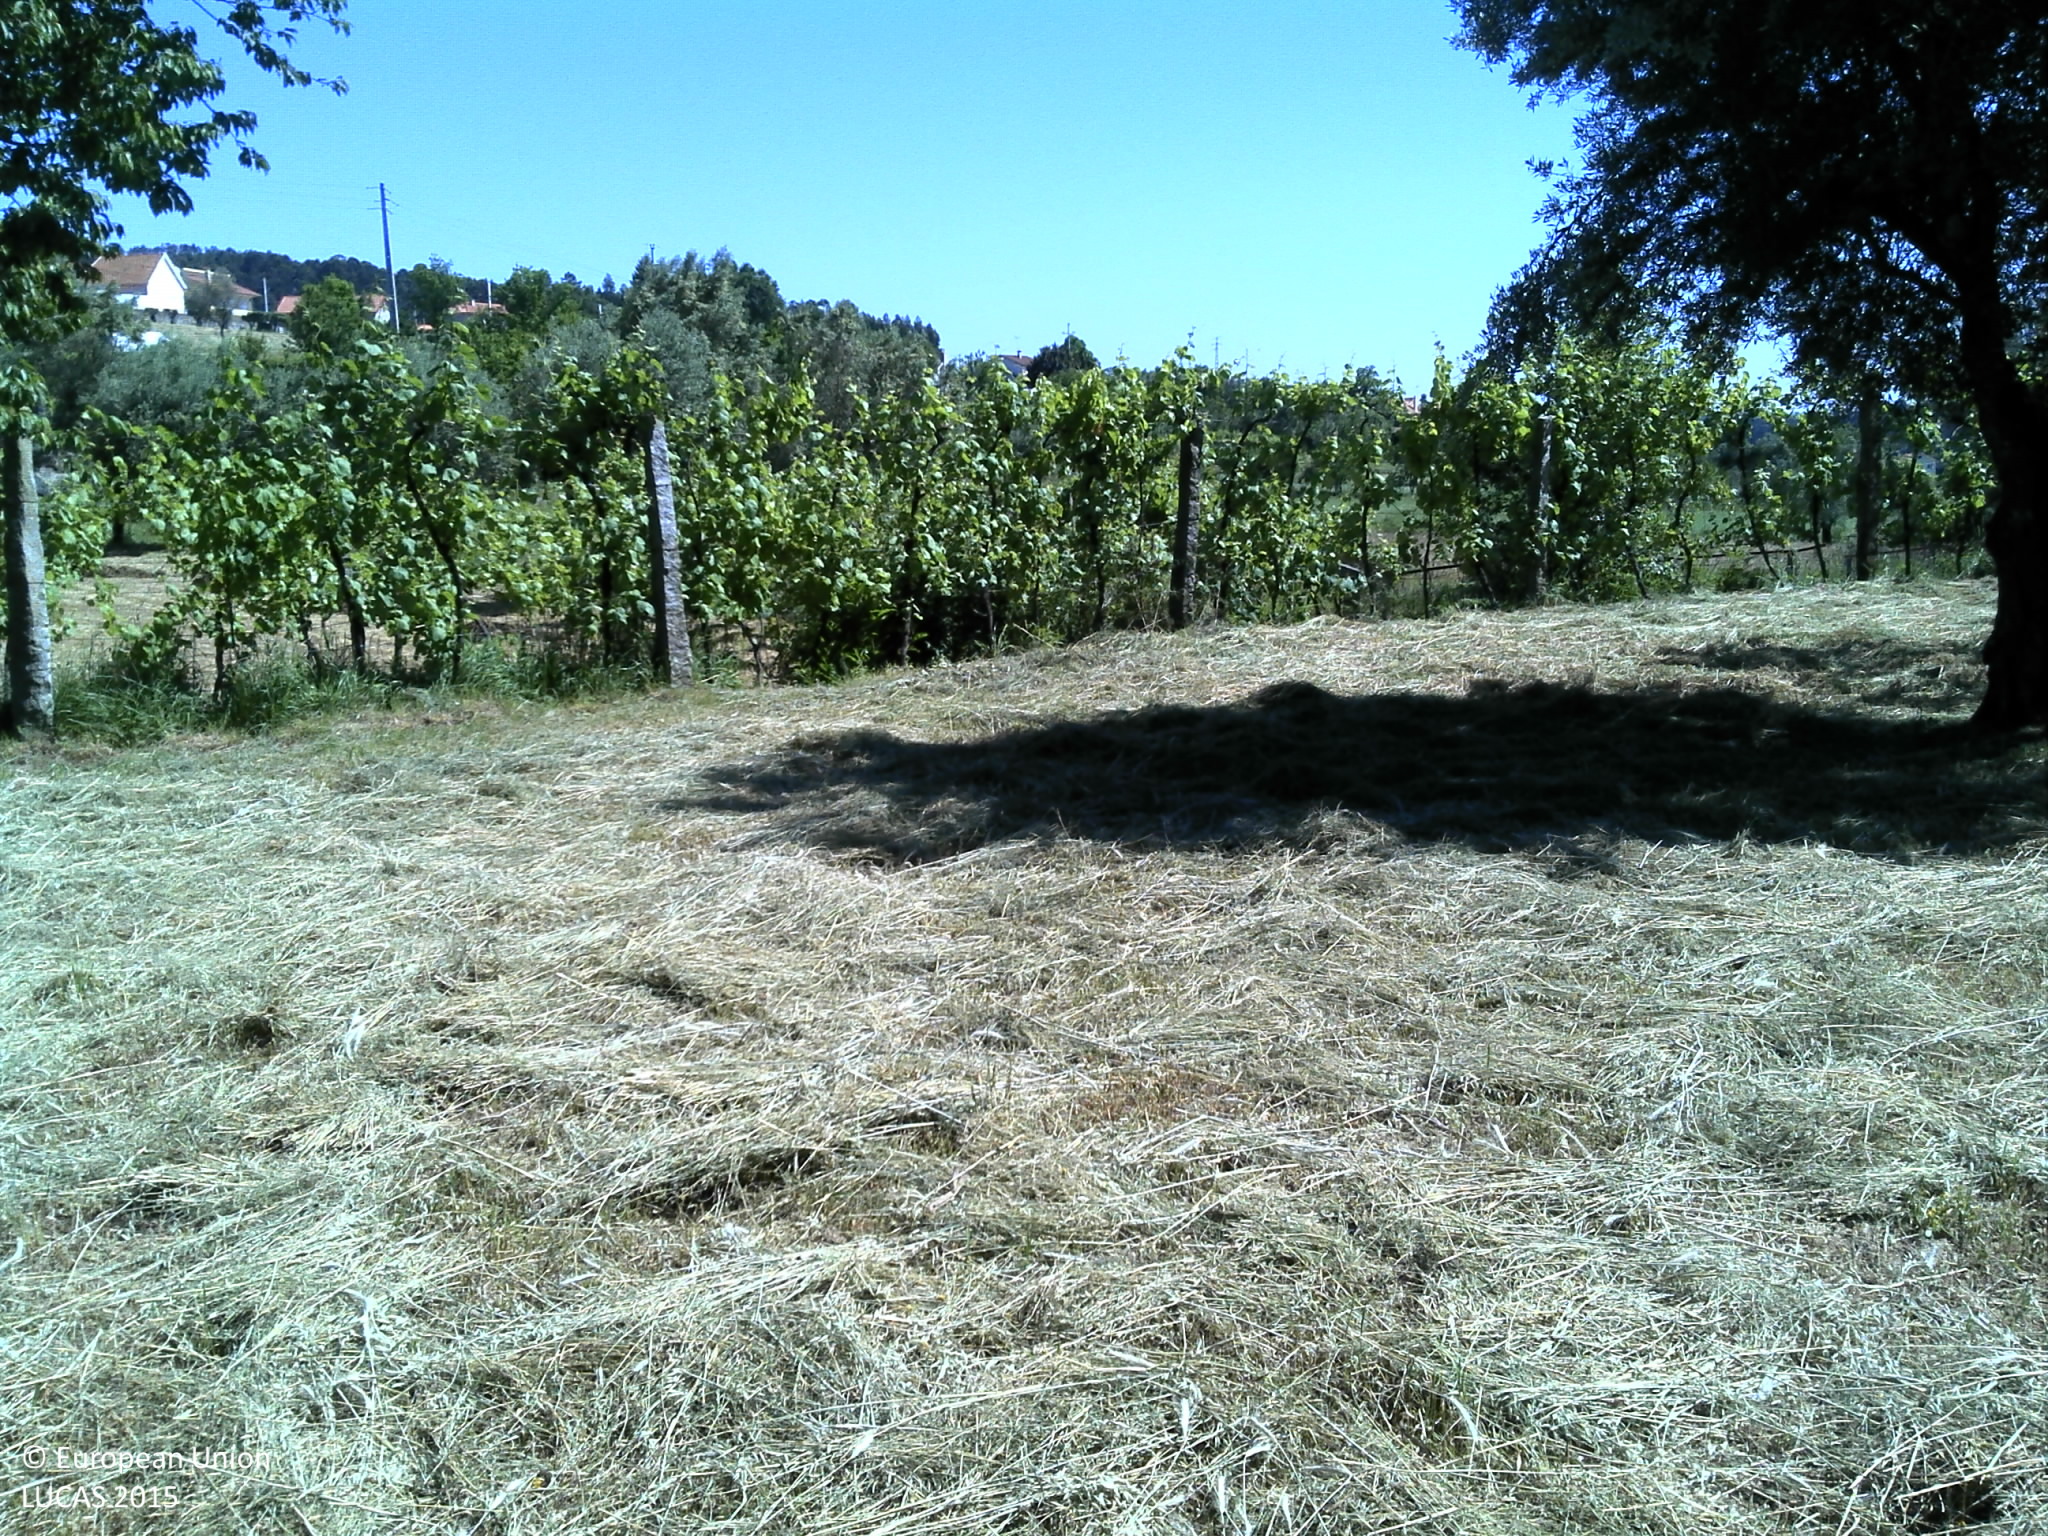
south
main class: Cropland
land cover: Temporary grasslands
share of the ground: 25 - 50 %
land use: Agriculture (excluding fallow land and kitchen gardens)
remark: Harvested field
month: May
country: PT
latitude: 41.6932
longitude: -8.5802
